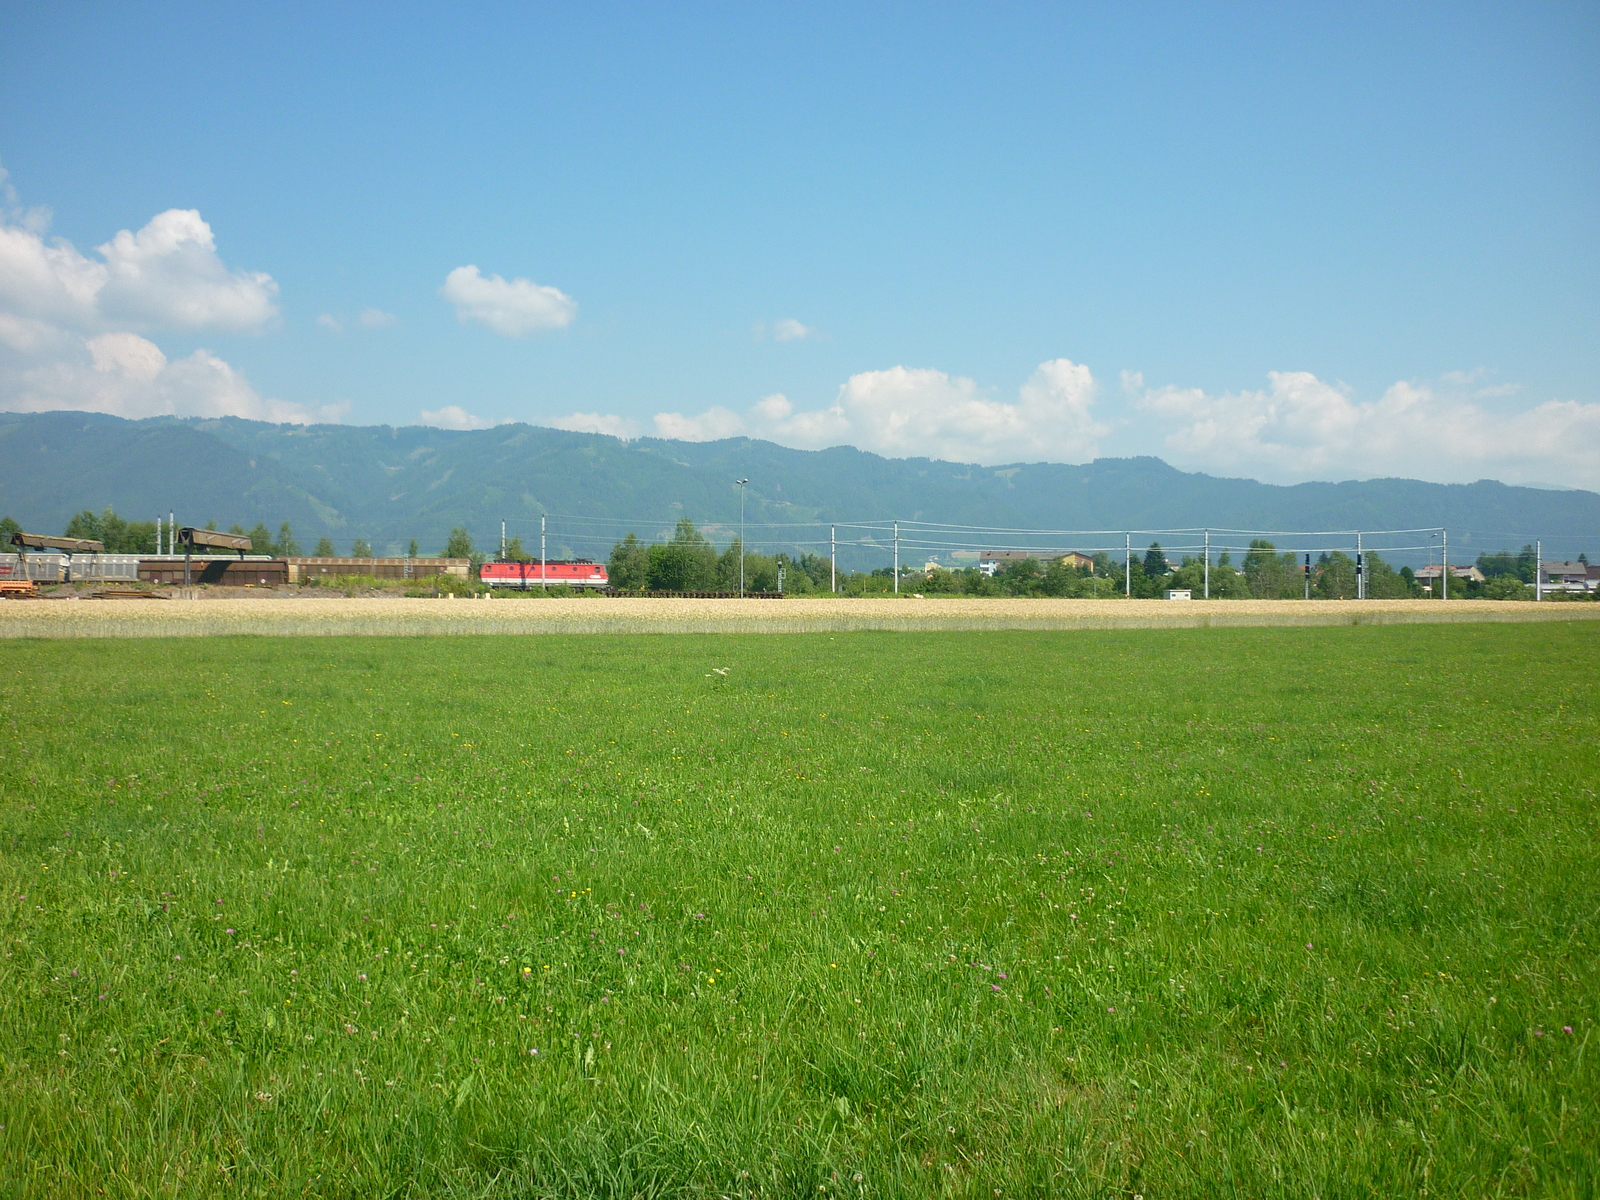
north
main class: Grassland
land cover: Grassland without tree/shrub cover
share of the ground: > 75 %
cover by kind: herbaceous plants 100 %
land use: Agriculture (excluding fallow land and kitchen gardens)
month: July
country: AT
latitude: 47.1843
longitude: 14.7365
